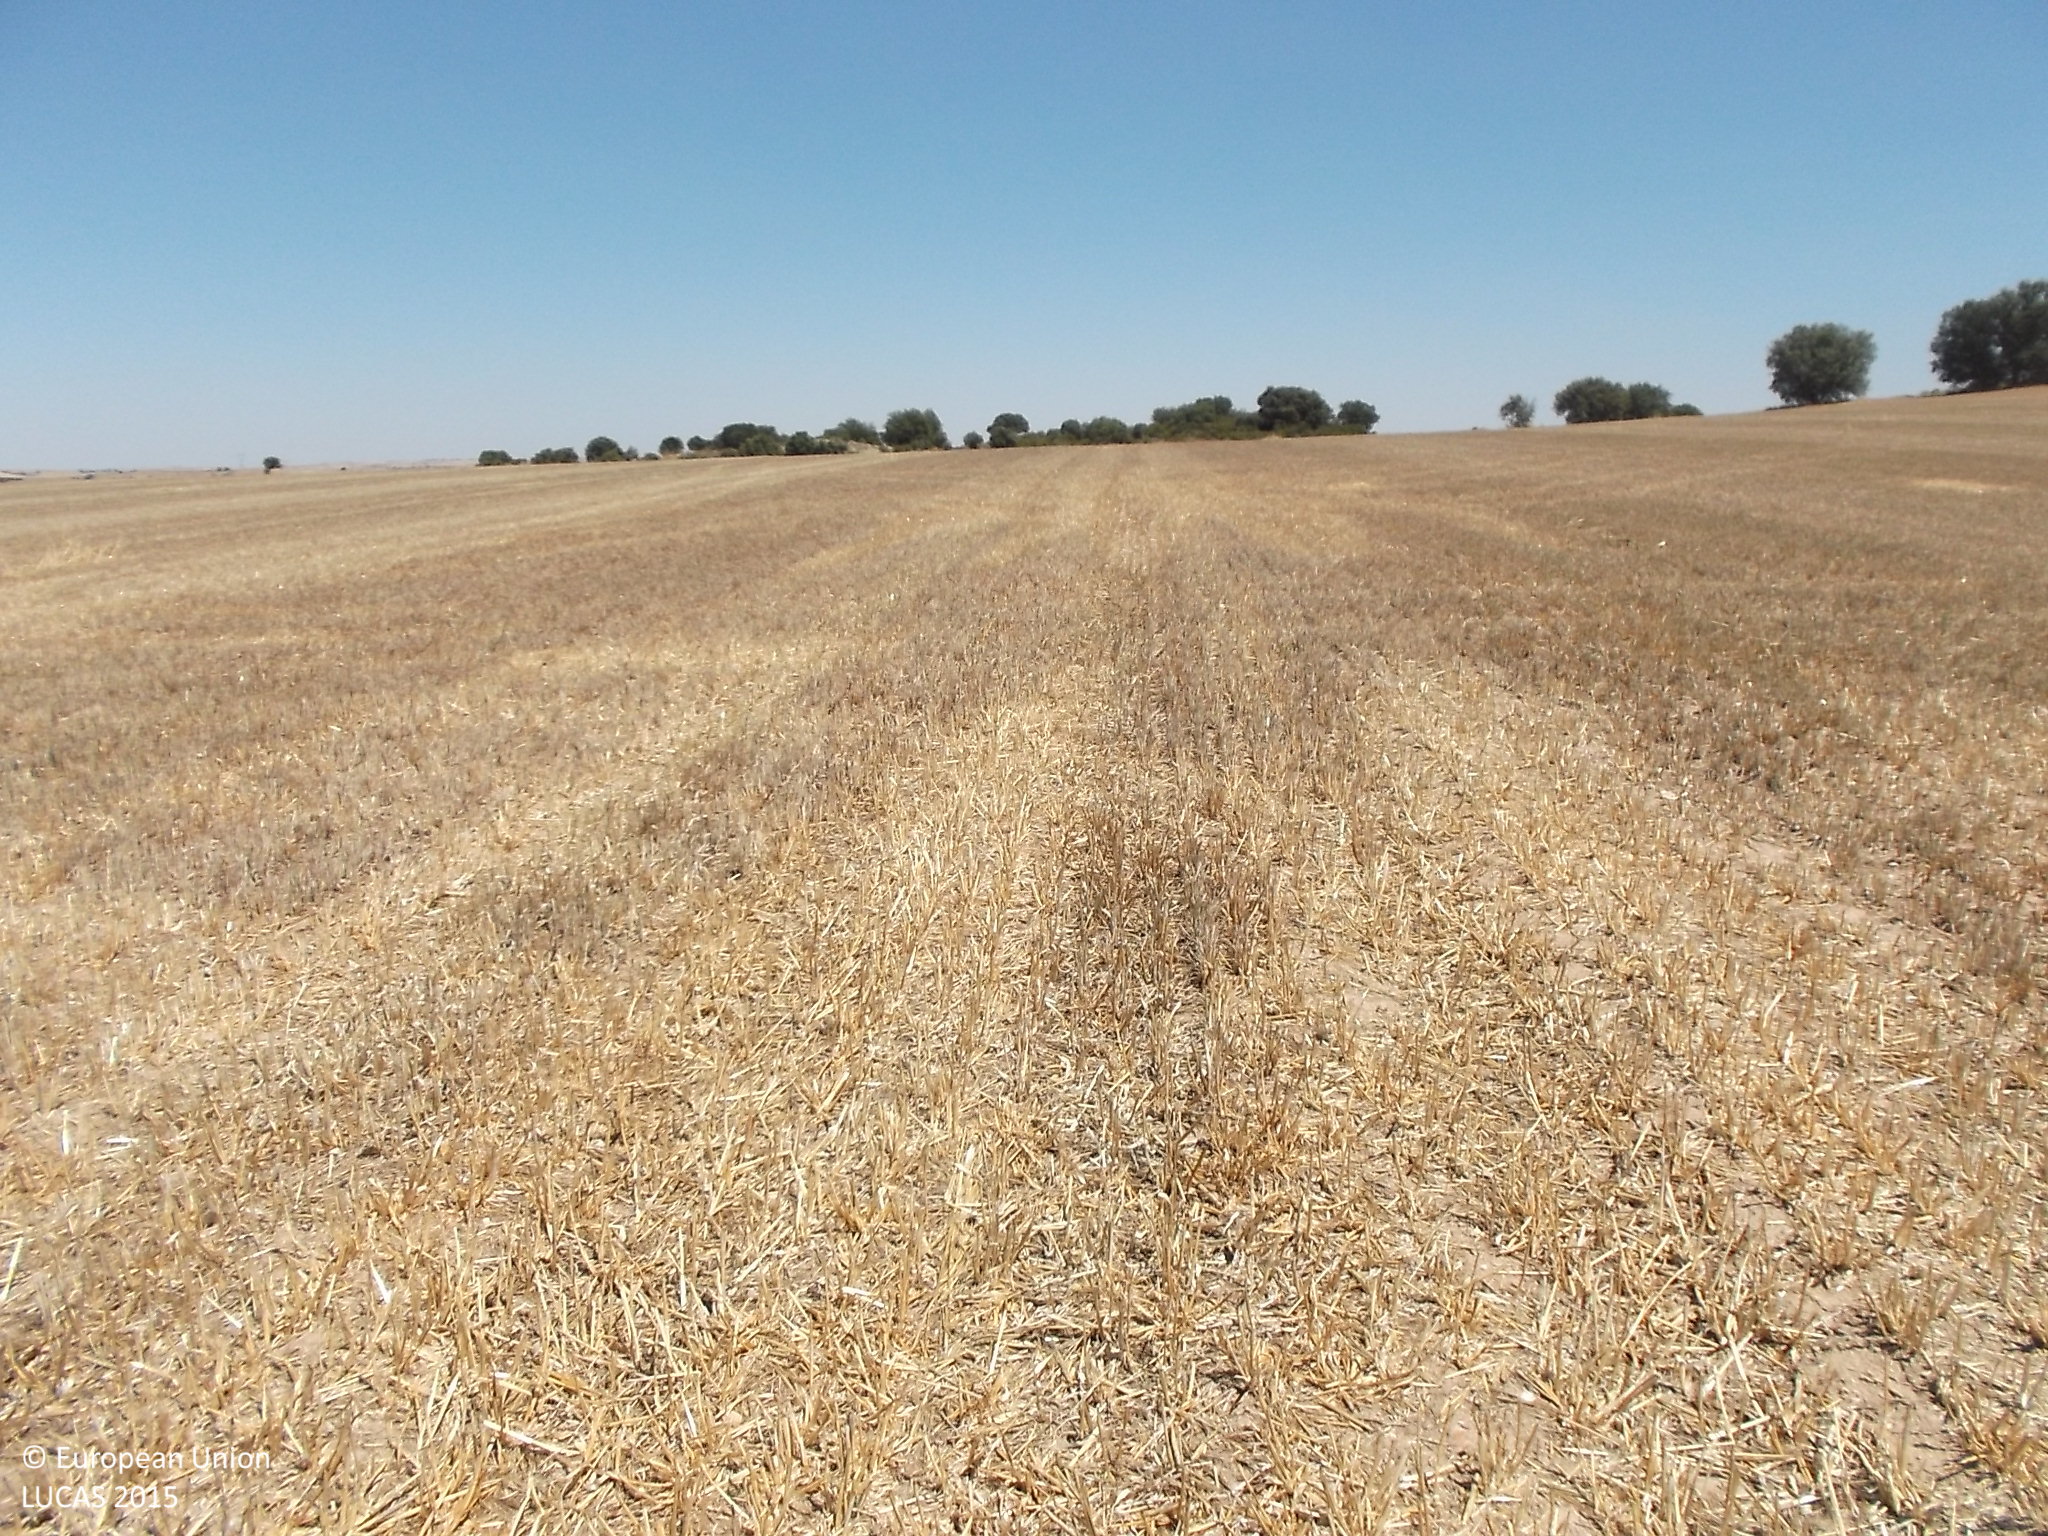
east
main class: Cropland
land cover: Oats
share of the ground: < 10 %
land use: Agriculture (excluding fallow land and kitchen gardens)
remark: Harvested field
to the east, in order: Oats; Grassland without tree/shrub cover; Rock outcrops
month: July
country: ES
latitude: 41.3770
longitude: -5.8581
